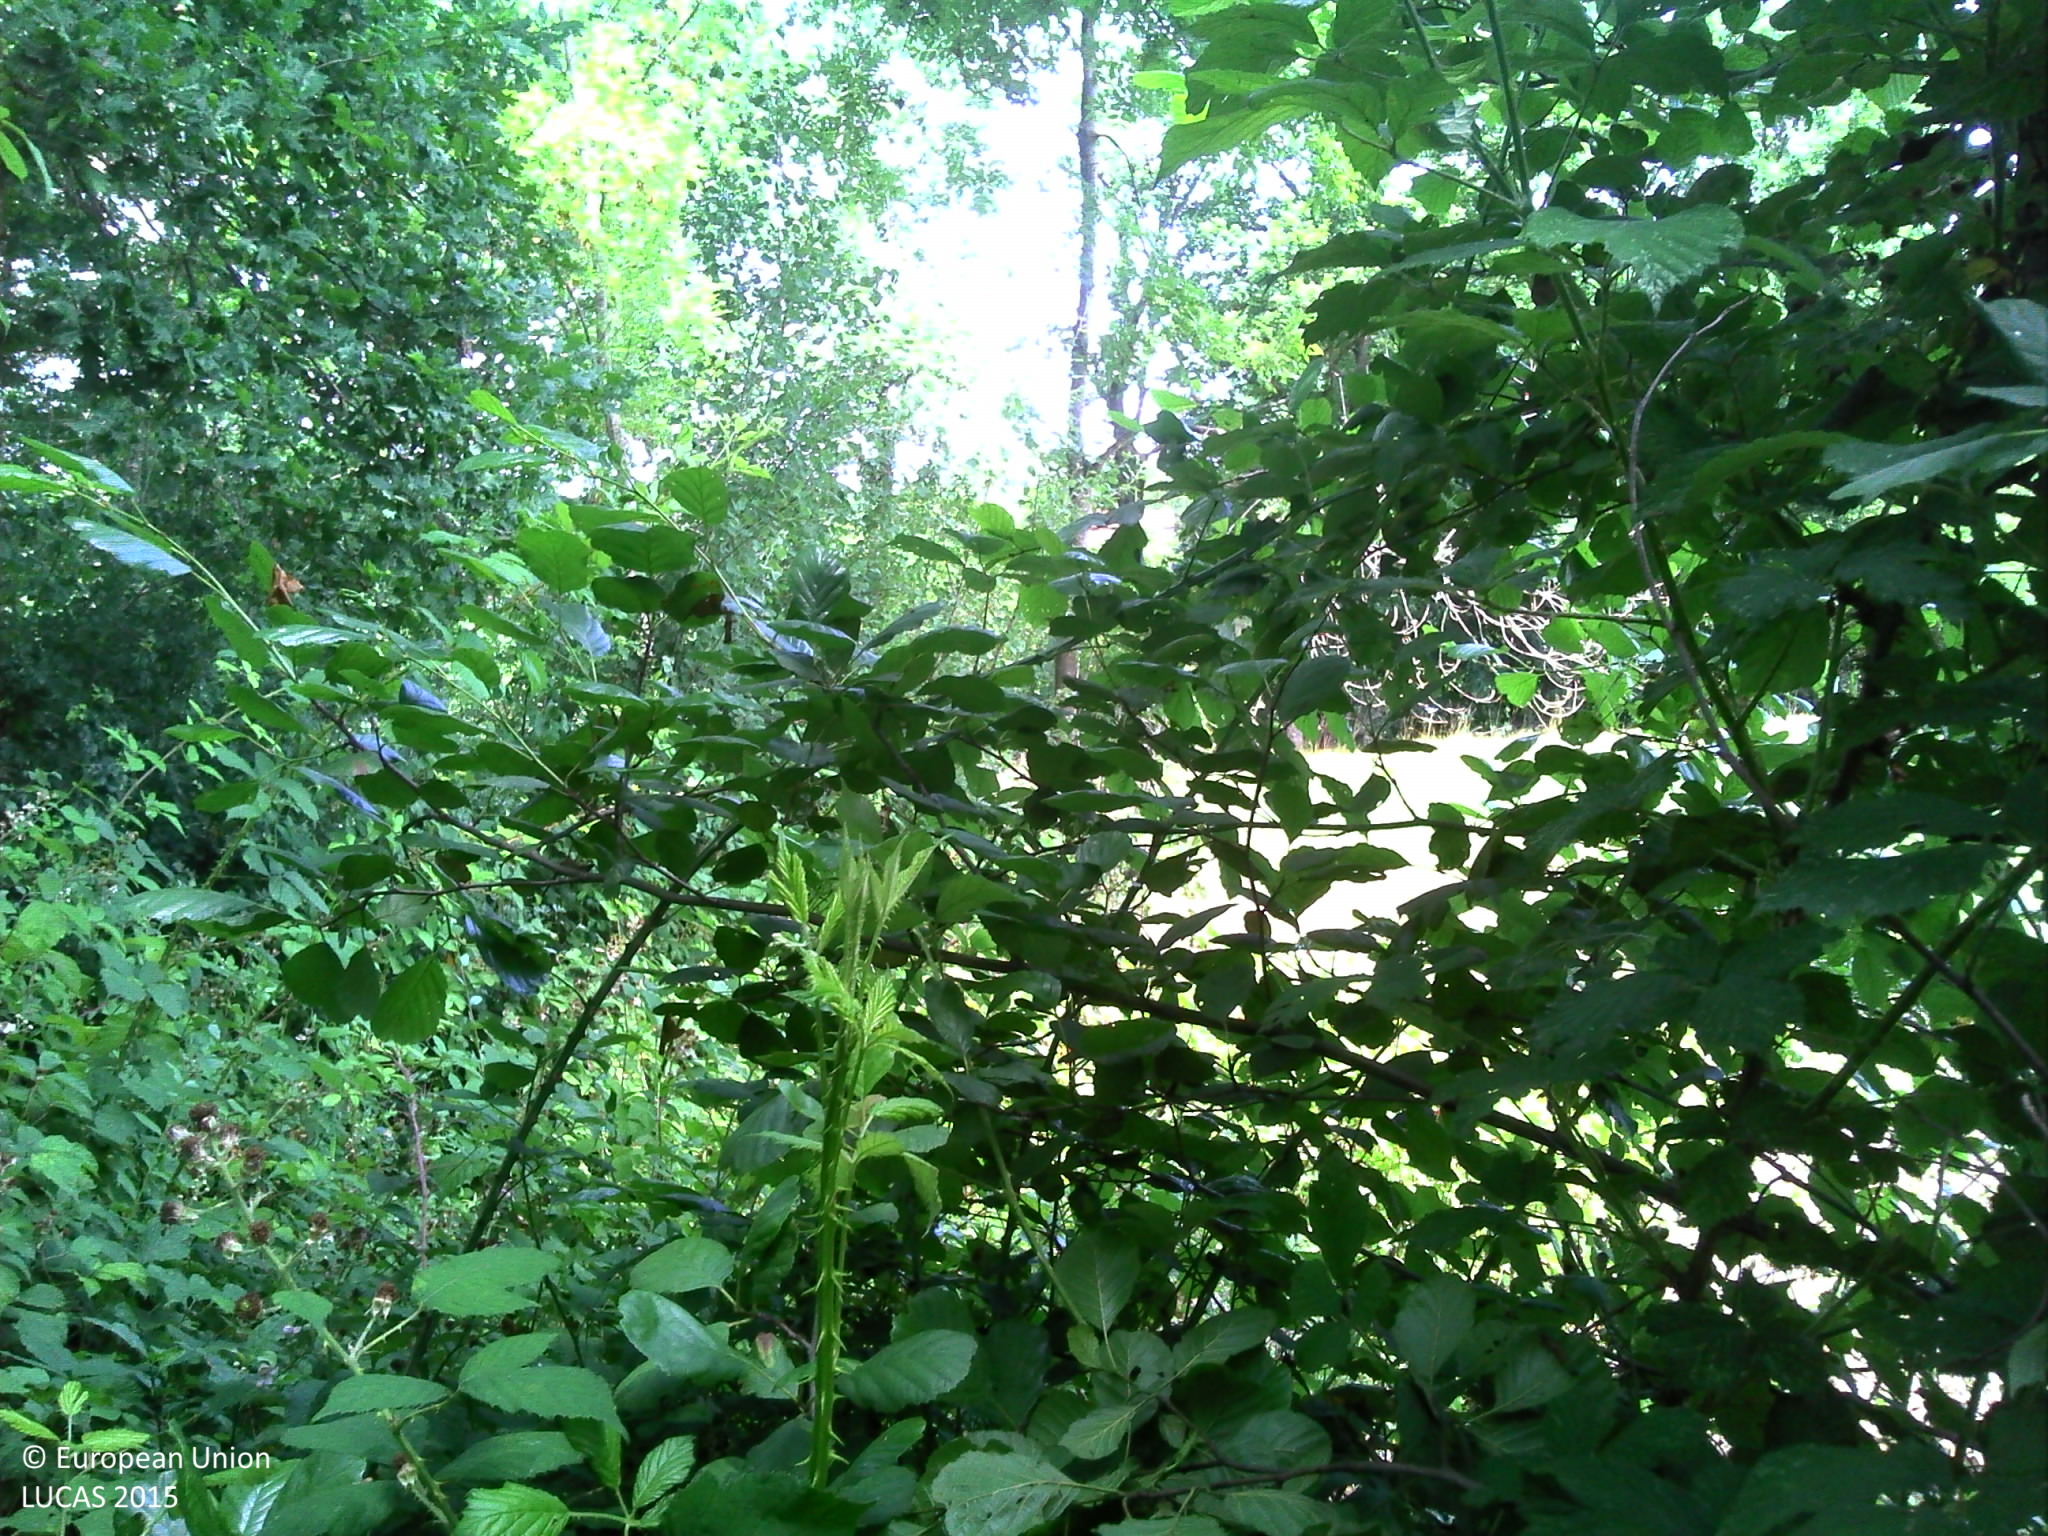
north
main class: Woodland
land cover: Broadleaved woodland
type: acidophilous oak and oak-birch forest
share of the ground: > 75 %
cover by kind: broadleaved forest trees 70 %, shrubs 20 %, herbaceous plants 10 %
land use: Forestry
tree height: > 5 m
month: June
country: FR
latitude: 46.4477
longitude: 5.3292
